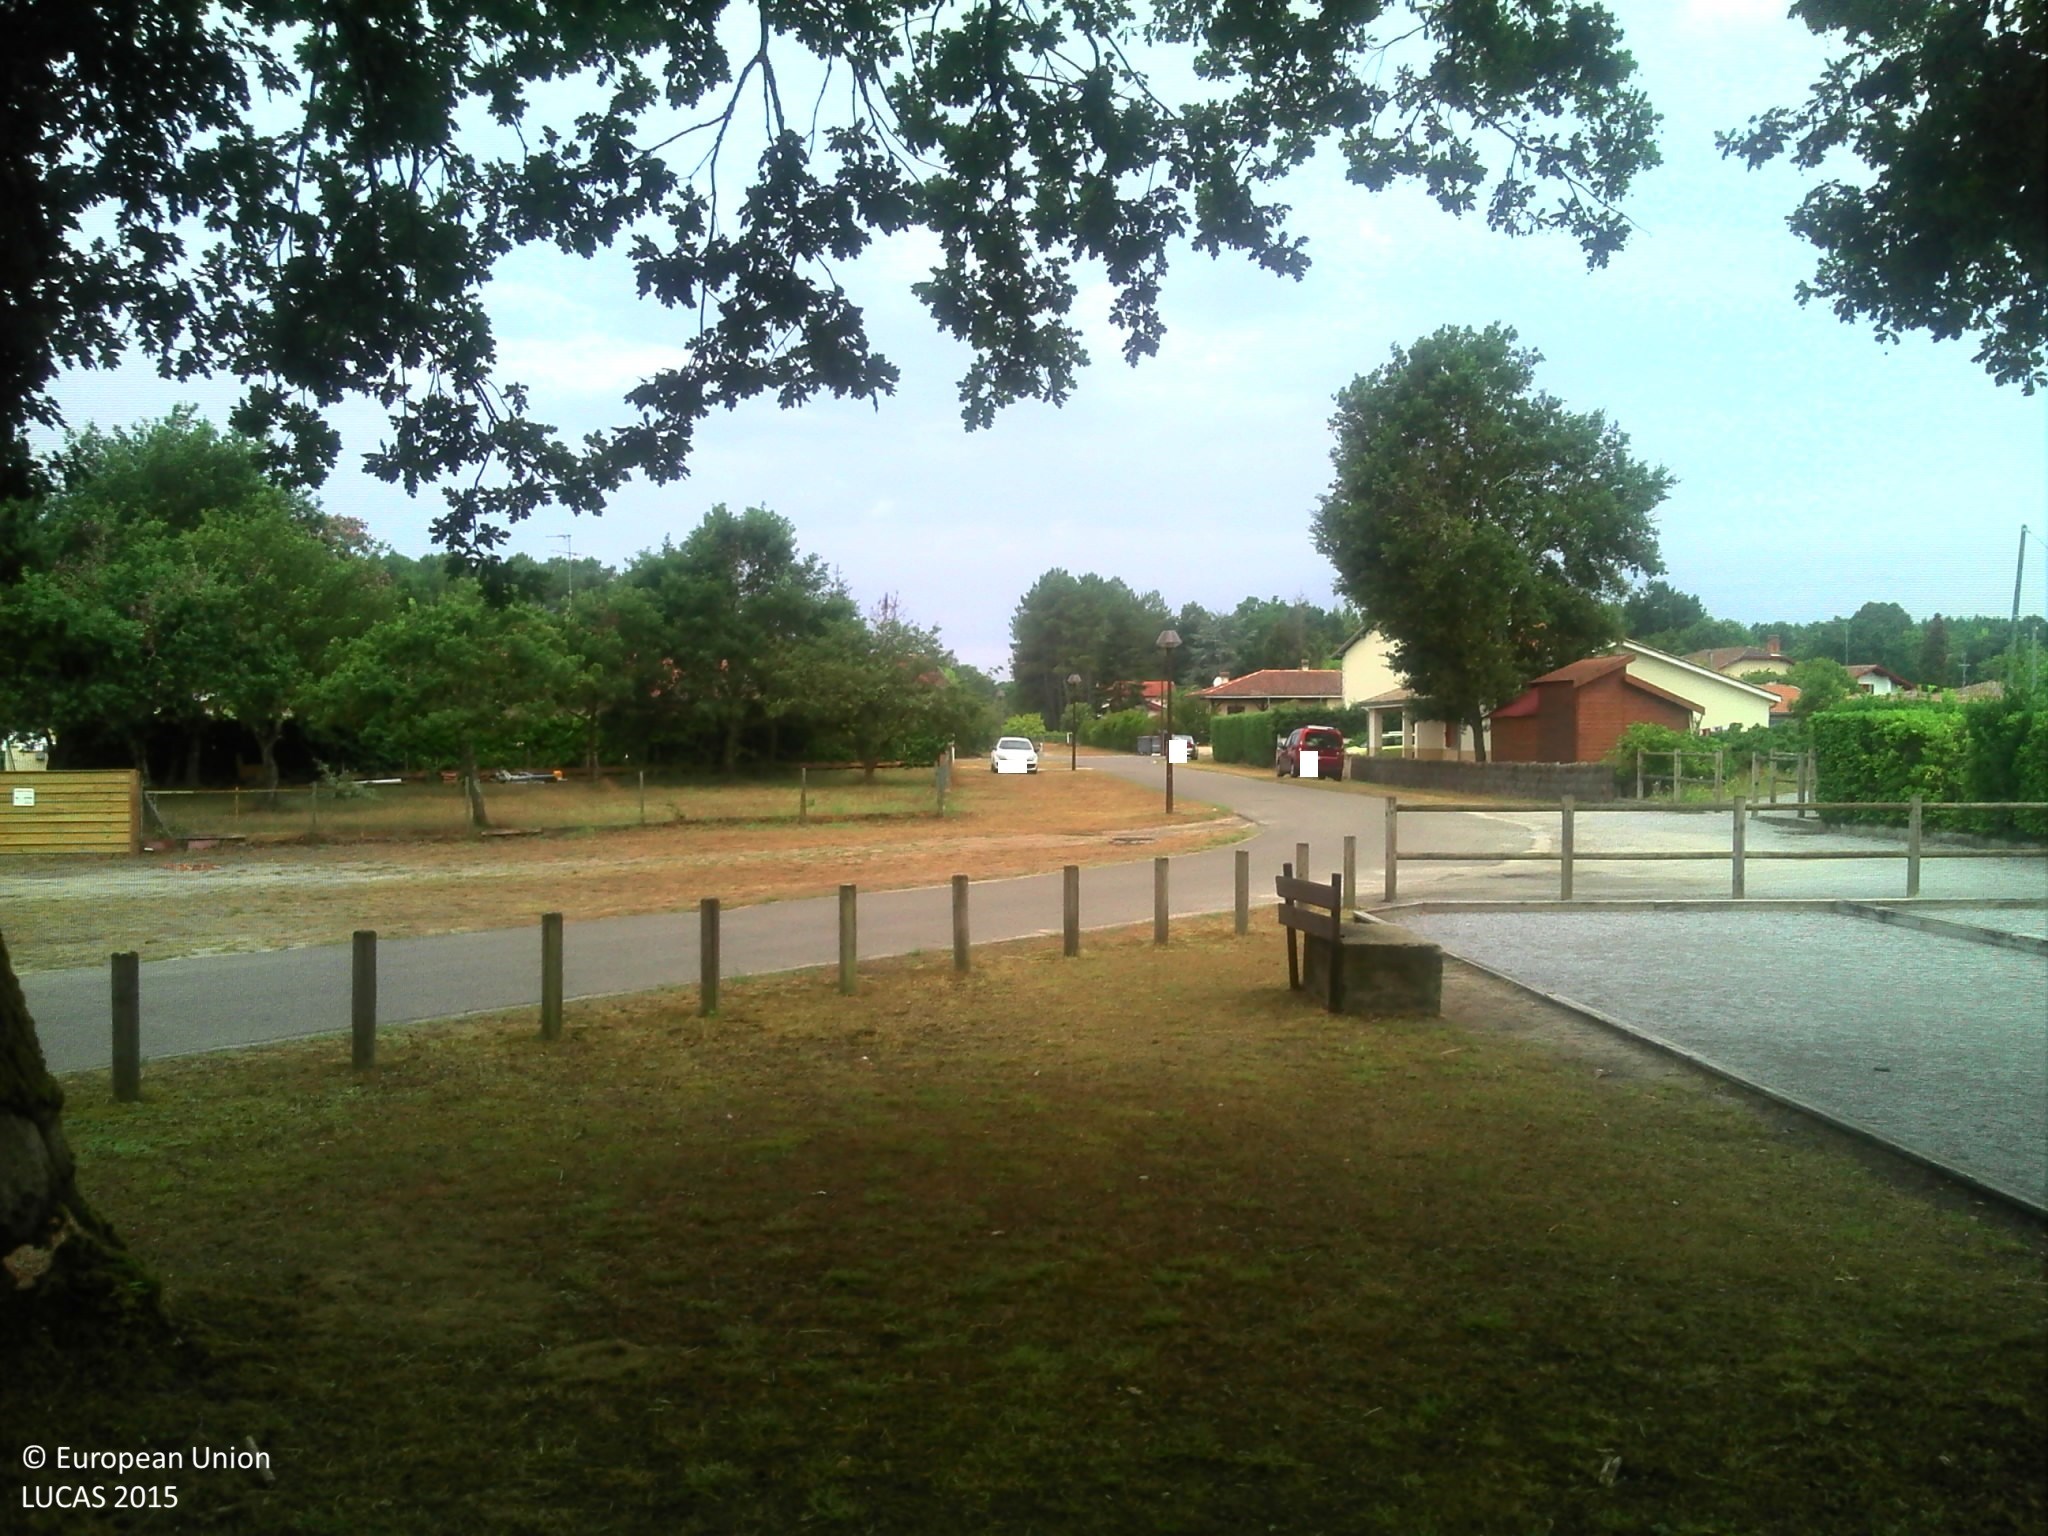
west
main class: Grassland
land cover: Grassland with sparse tree/shrub cover
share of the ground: > 75 %
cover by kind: herbaceous plants 85 %, lichens and mosses 10 %, broadleaved forest trees 5 %
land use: Sport
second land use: Amenities, museums, leisure
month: July
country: FR
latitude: 43.8032
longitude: -1.1419
